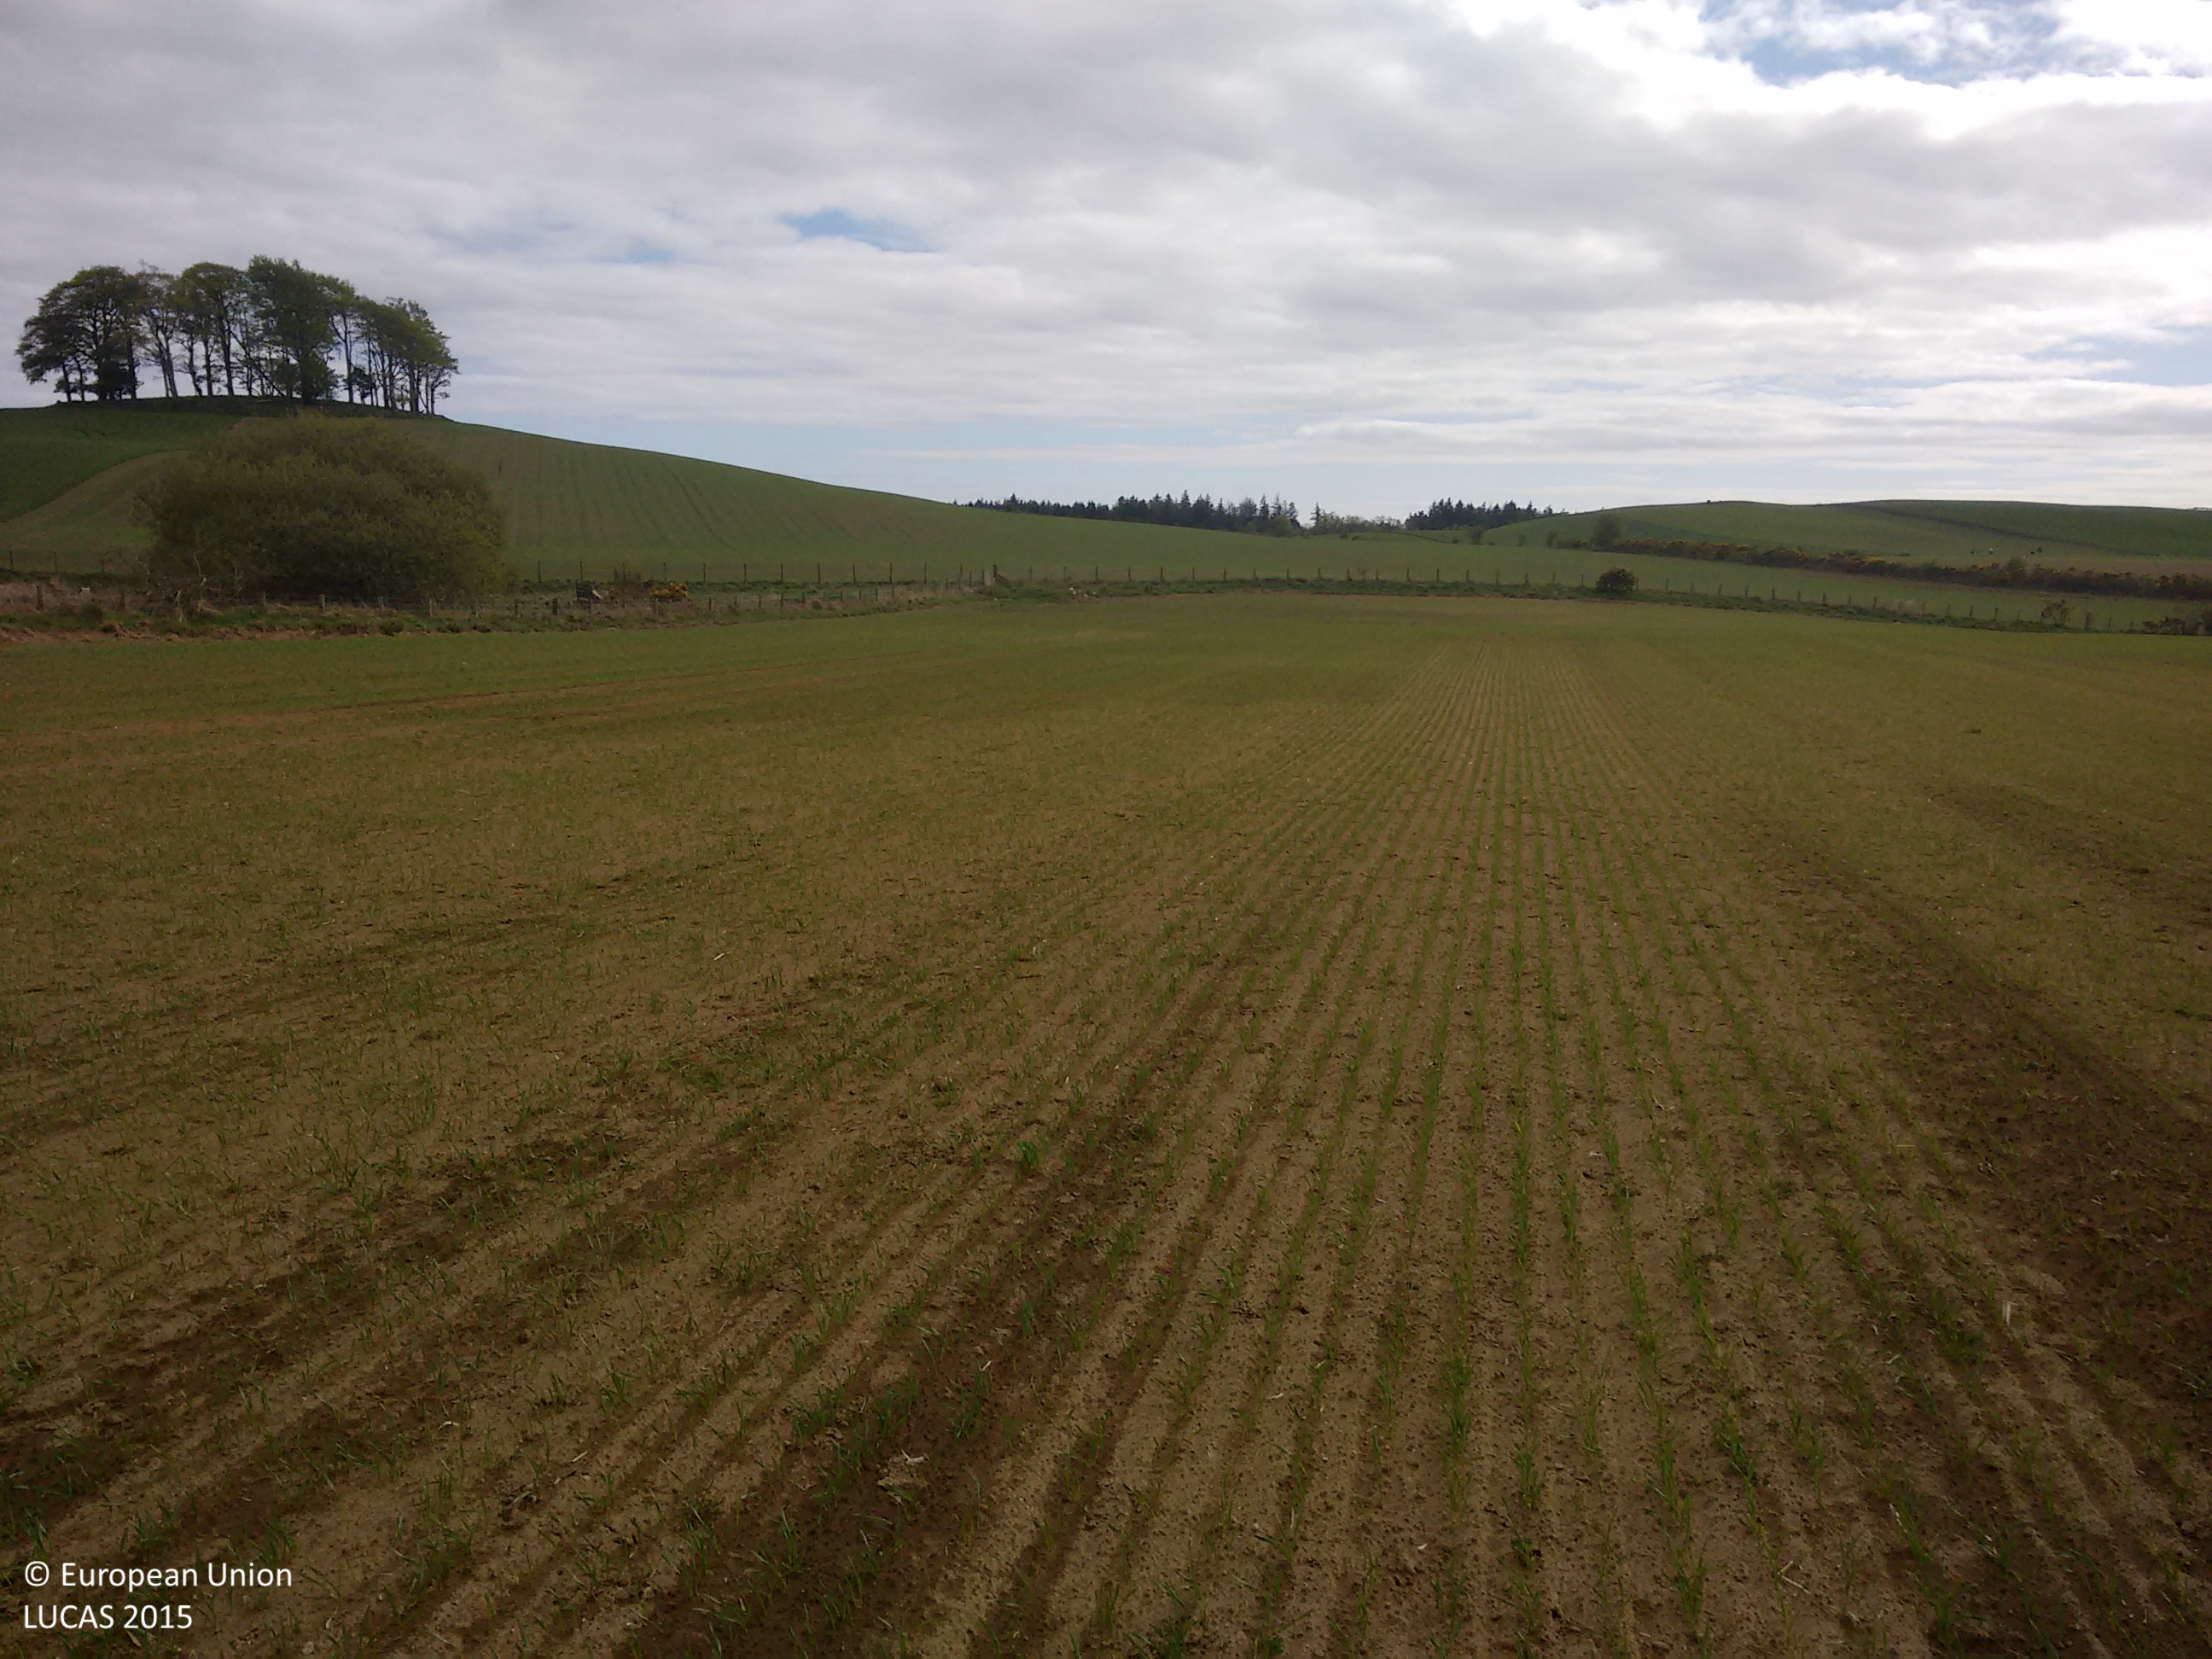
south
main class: Cropland
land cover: Common wheat
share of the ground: 25 - 50 %
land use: Agriculture (excluding fallow land and kitchen gardens)
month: May
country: GB
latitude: 56.7003
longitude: -2.7170
